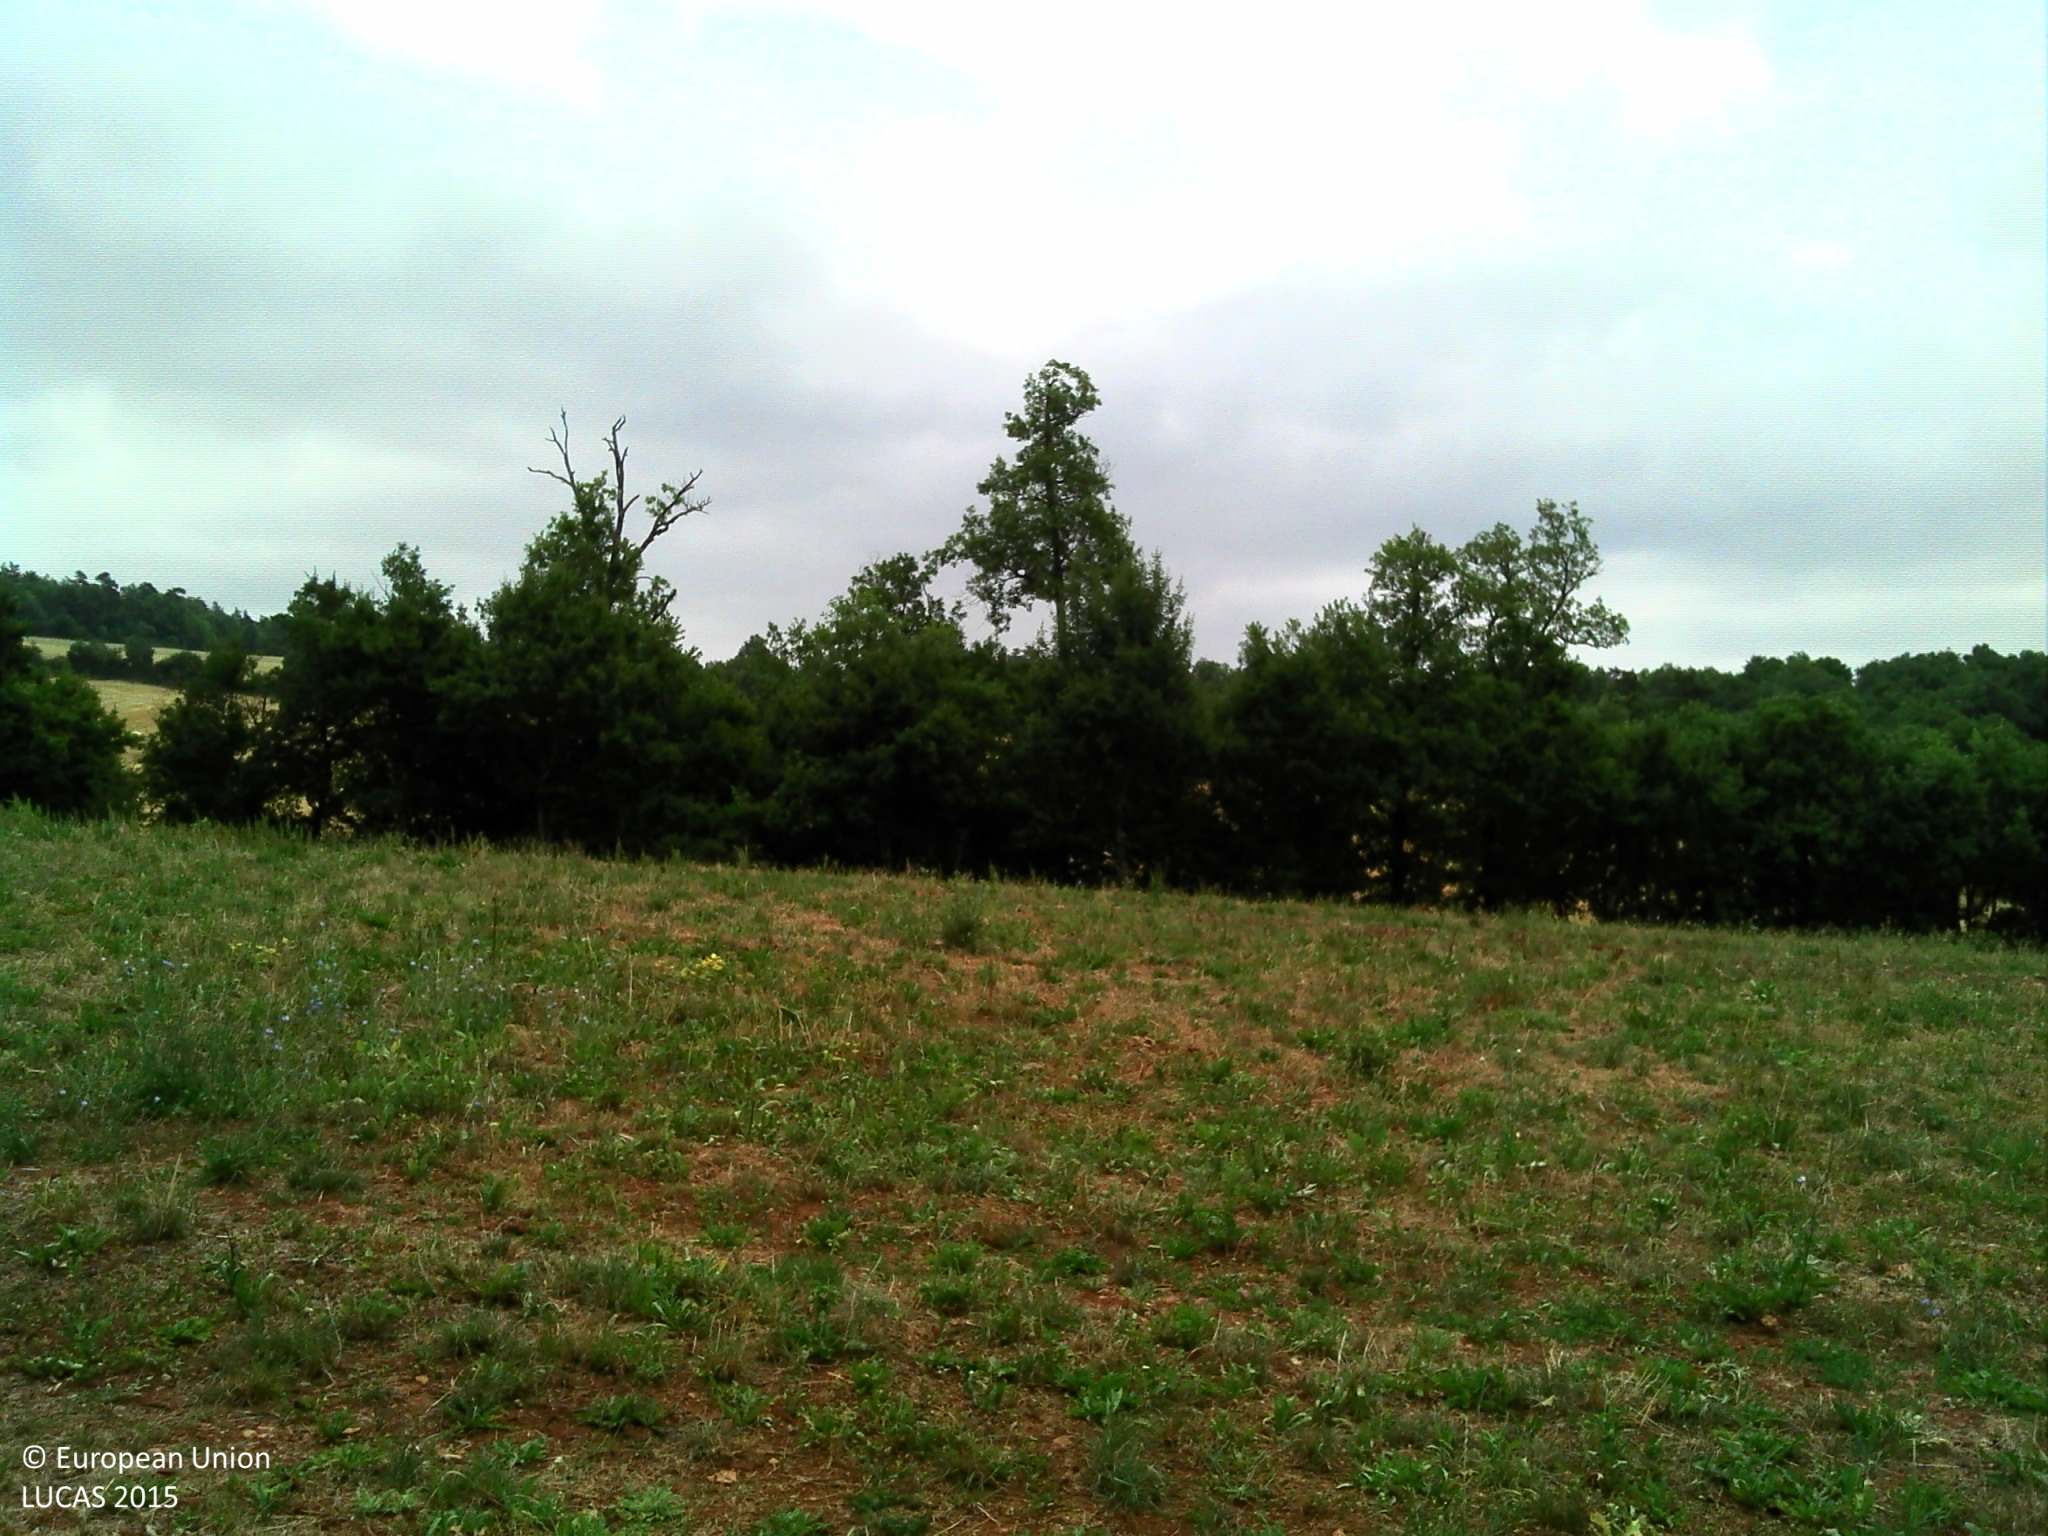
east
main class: Grassland
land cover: Spontaneously vegetated surfaces
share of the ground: 50 - 75 %
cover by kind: herbaceous plants 100 %
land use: Agriculture (excluding fallow land and kitchen gardens)
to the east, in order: Spontaneously vegetated surfaces; Fences; Broadleaved woodland; Barley
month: July
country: FR
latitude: 44.3930
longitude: 3.1126
